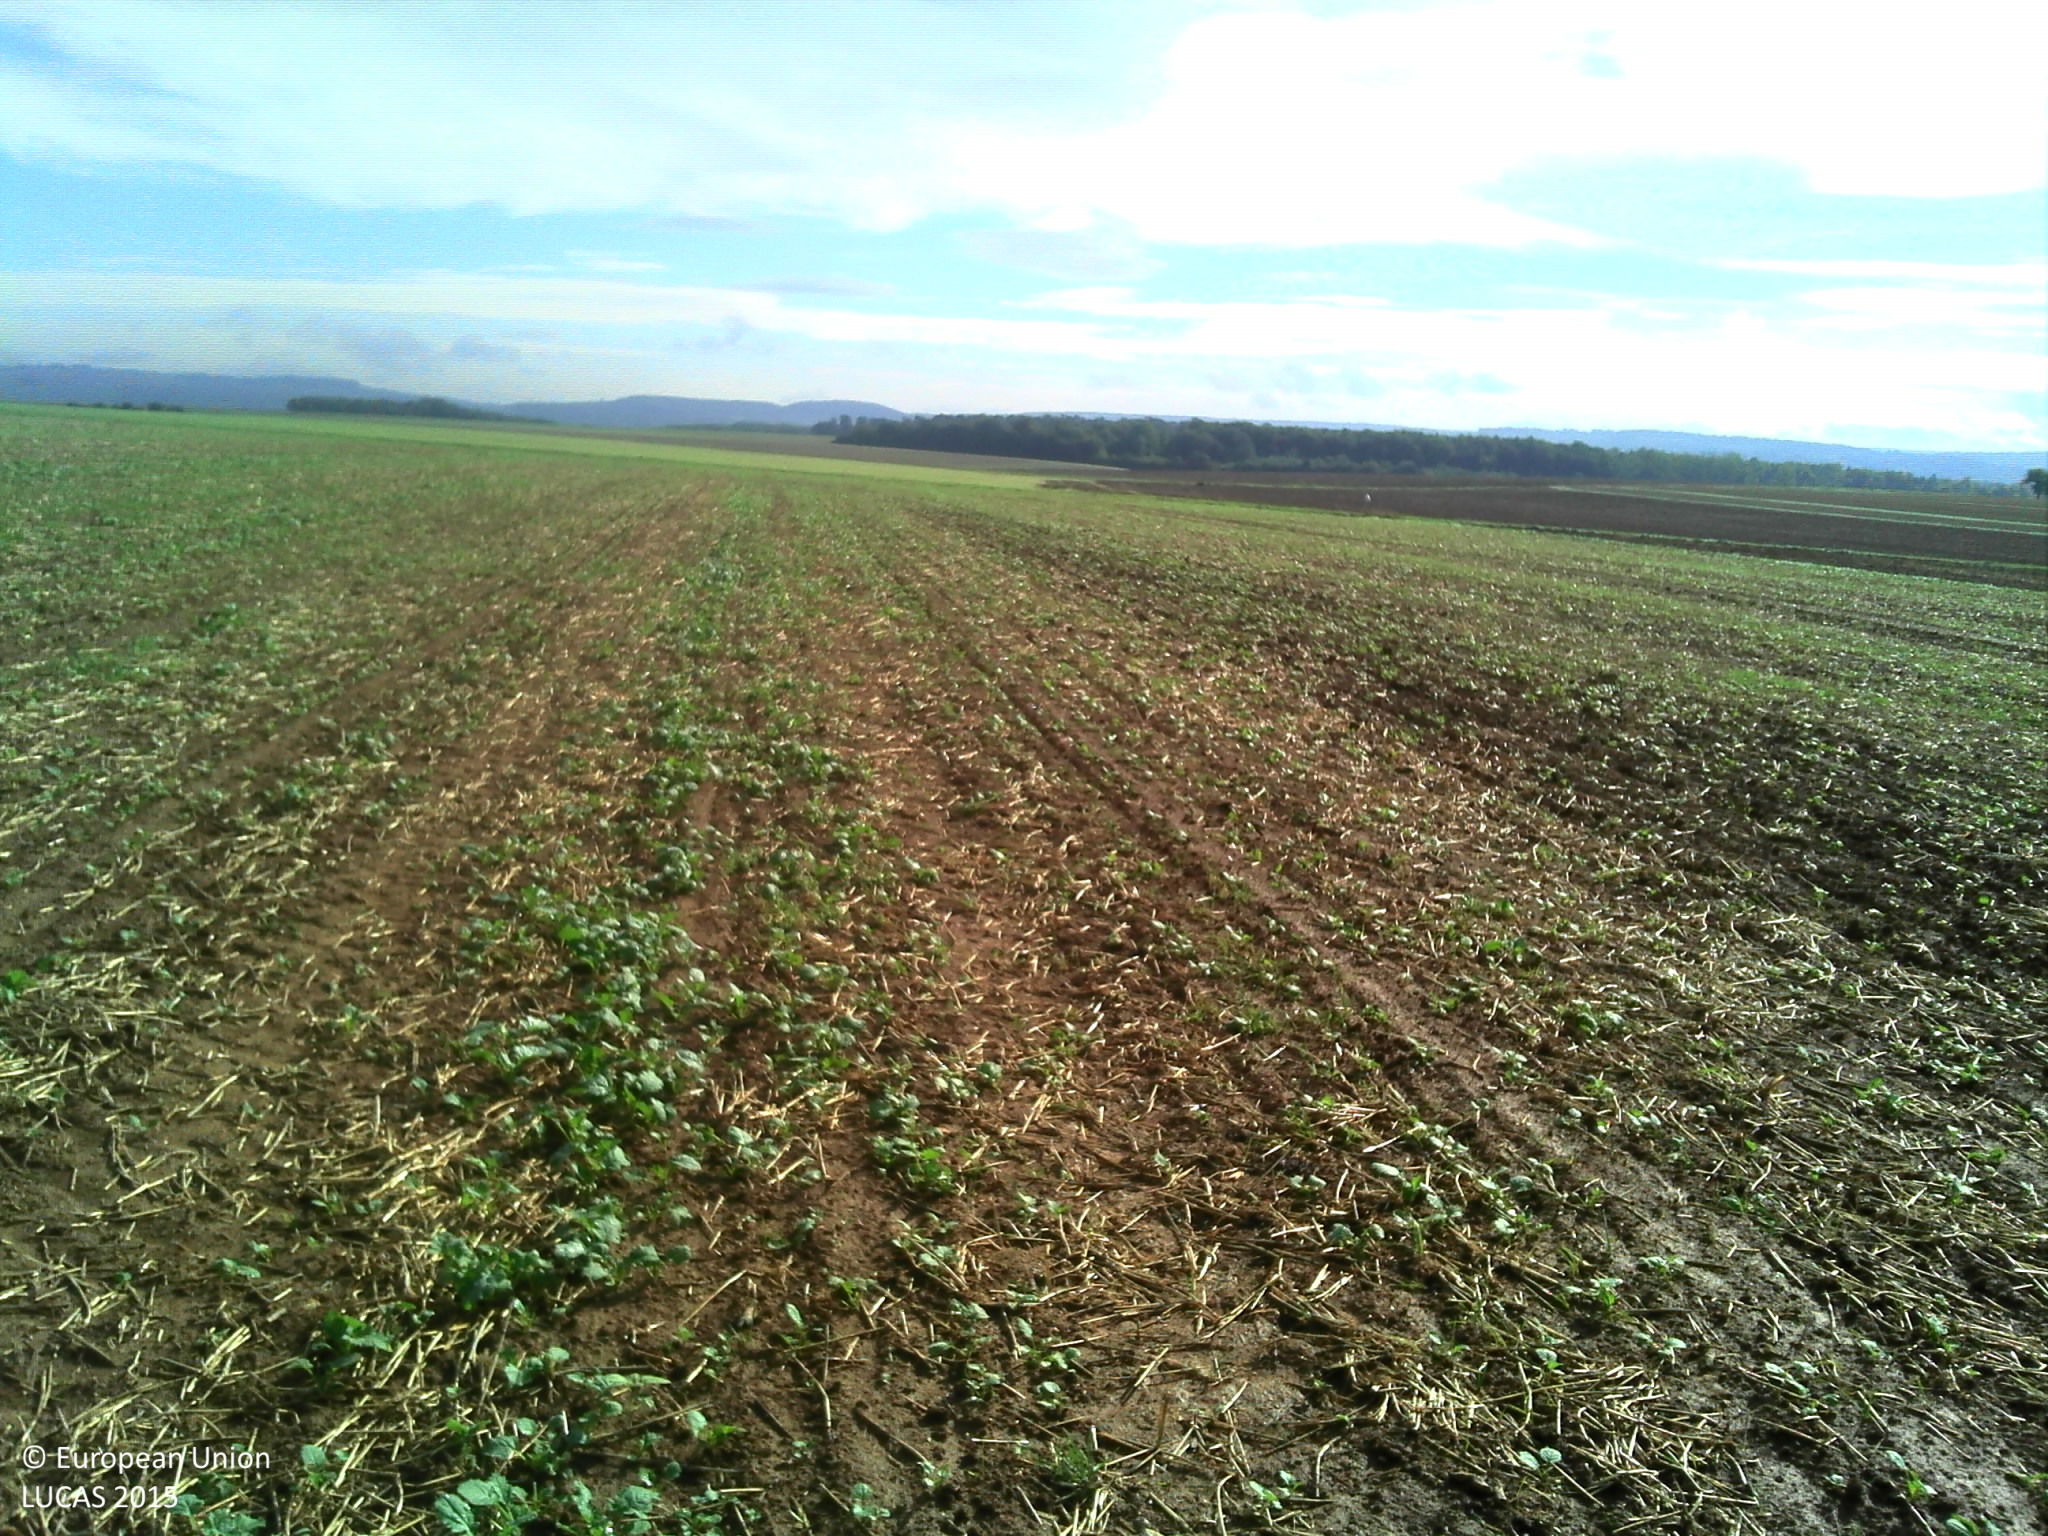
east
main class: Cropland
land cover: Other fibre and oleaginous crops
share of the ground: < 10 %
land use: Agriculture (excluding fallow land and kitchen gardens)
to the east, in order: Other fibre and oleaginous crops; Grass margins; Tracks; Grass margins; Common wheat
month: September
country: FR
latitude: 48.8179
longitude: 6.0093
